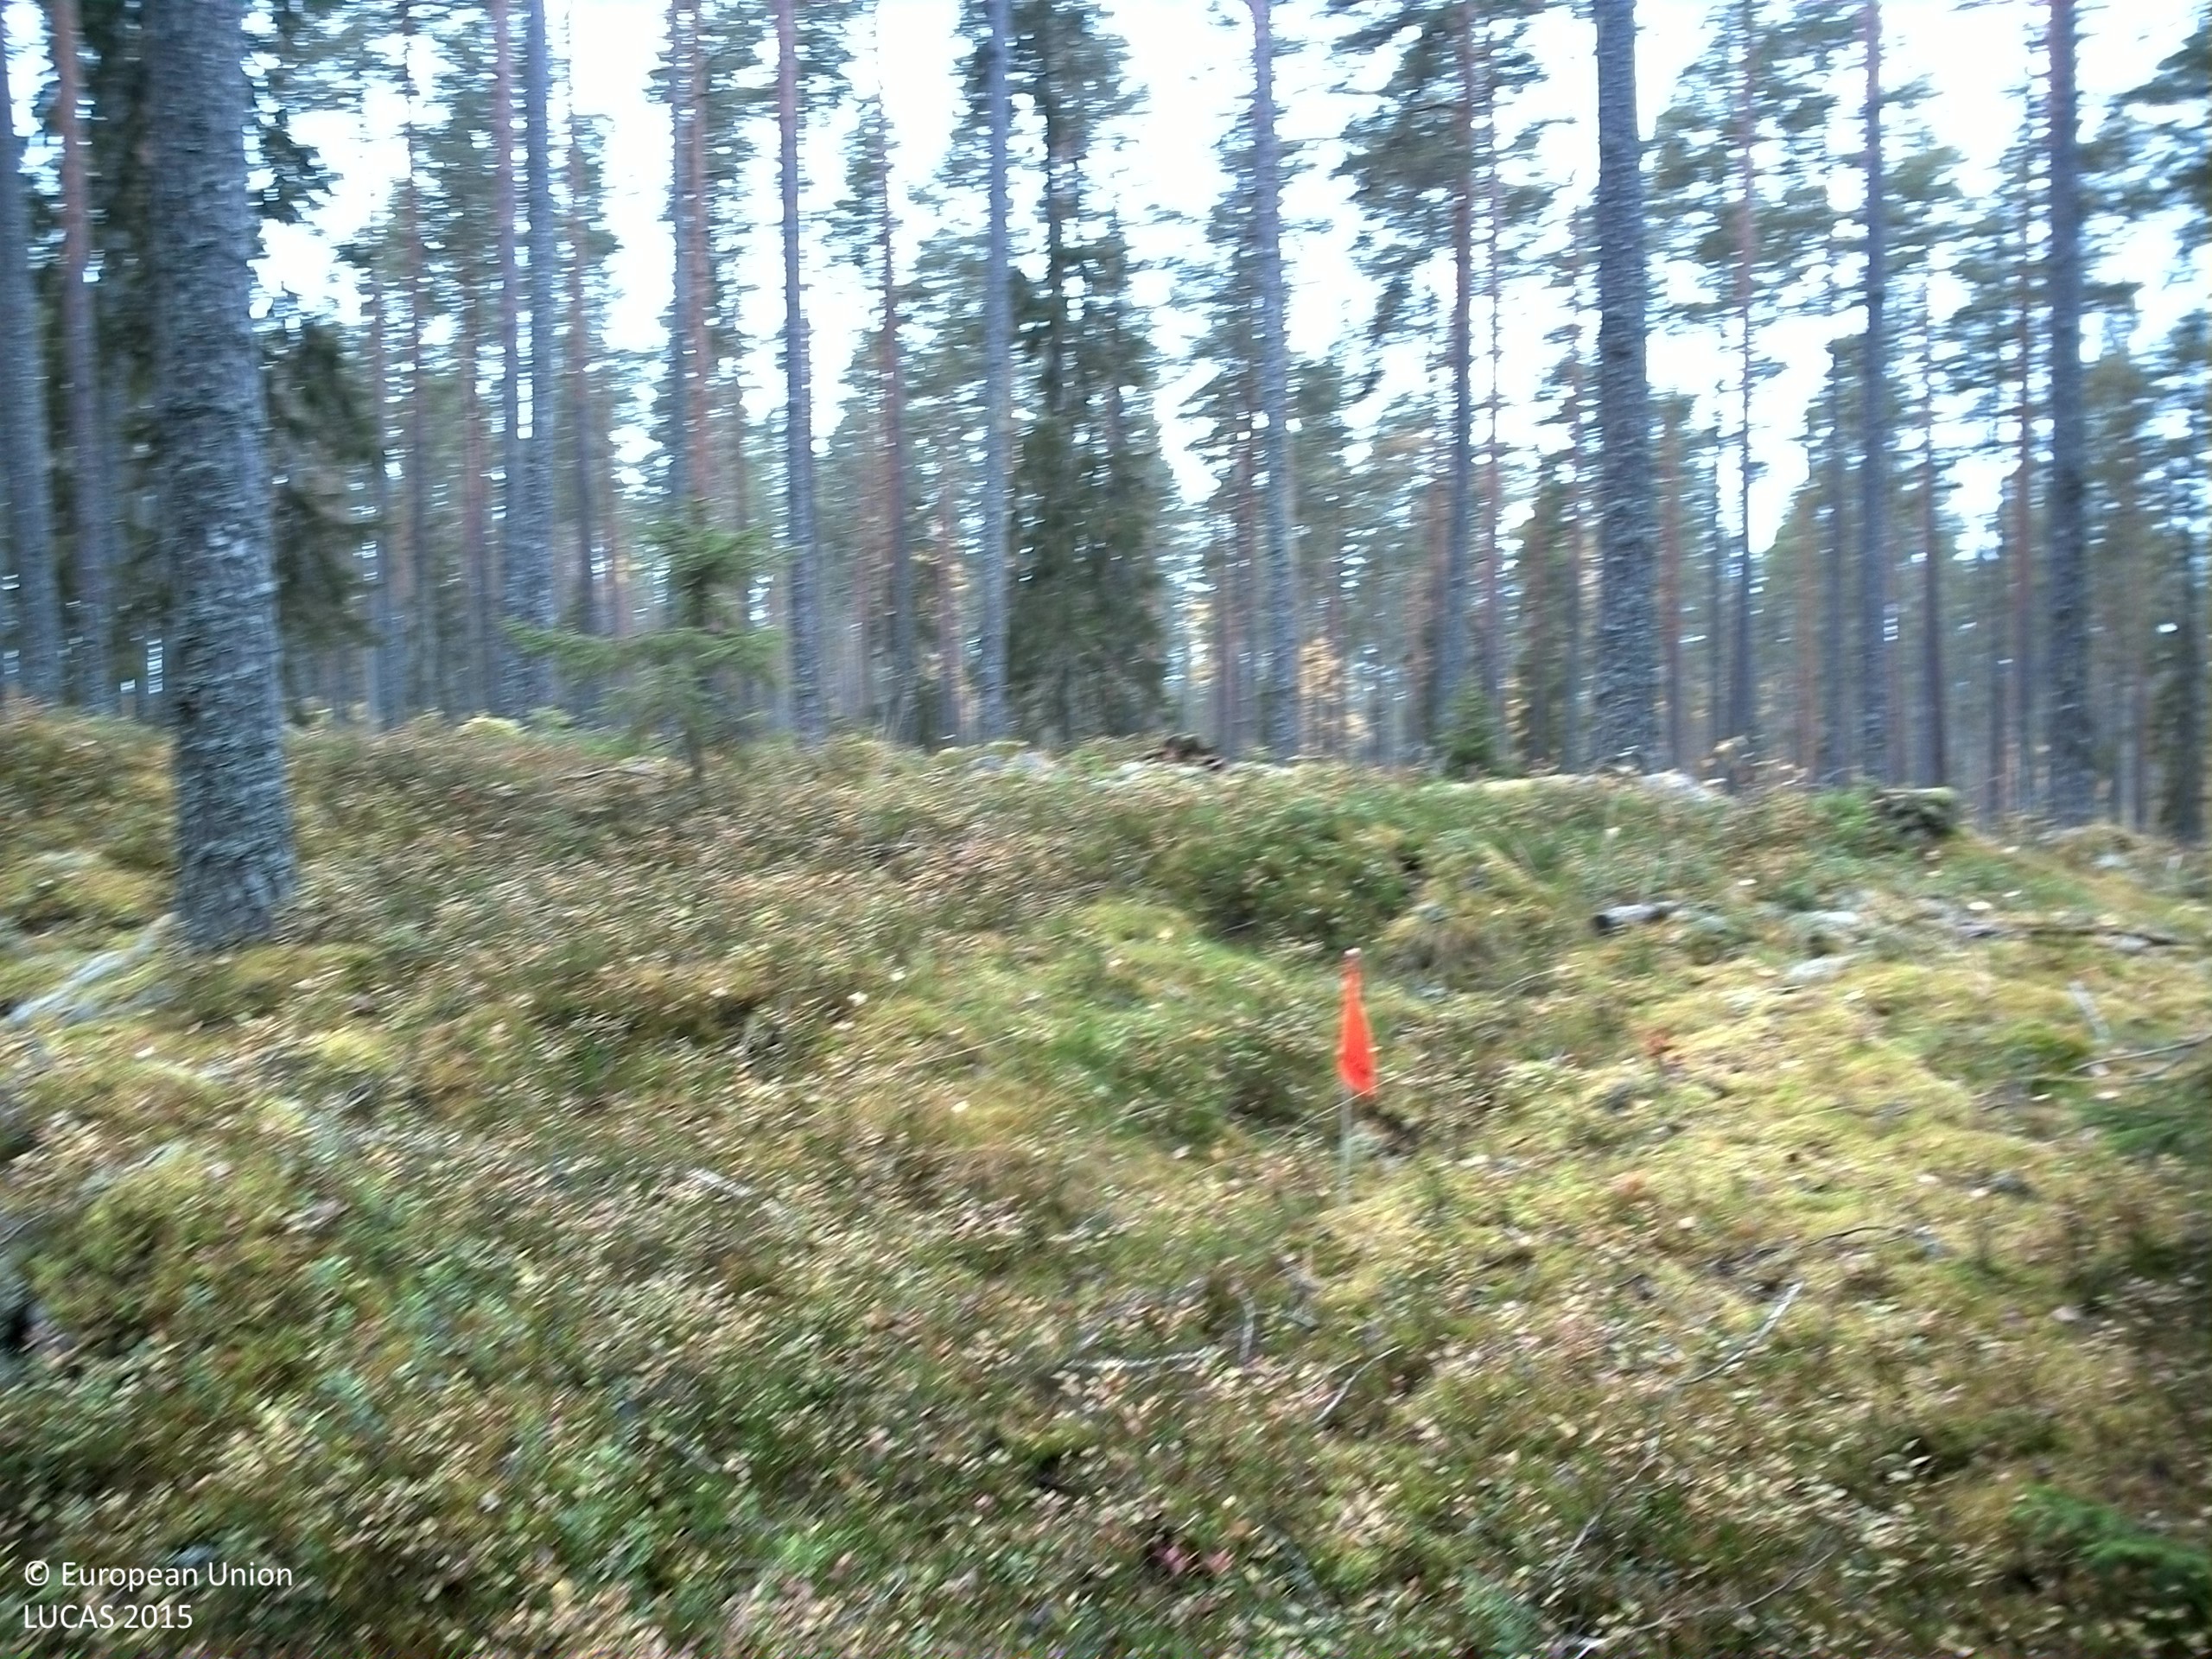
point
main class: Woodland
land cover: Pine dominated coniferous woodland
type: boreal forest
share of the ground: 50 - 75 %
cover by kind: coniferous forest trees 55 %, shrubs 25 %, lichens and mosses 20 %
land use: Forestry
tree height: > 5 m
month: October
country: SE
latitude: 61.2326
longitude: 14.3263
